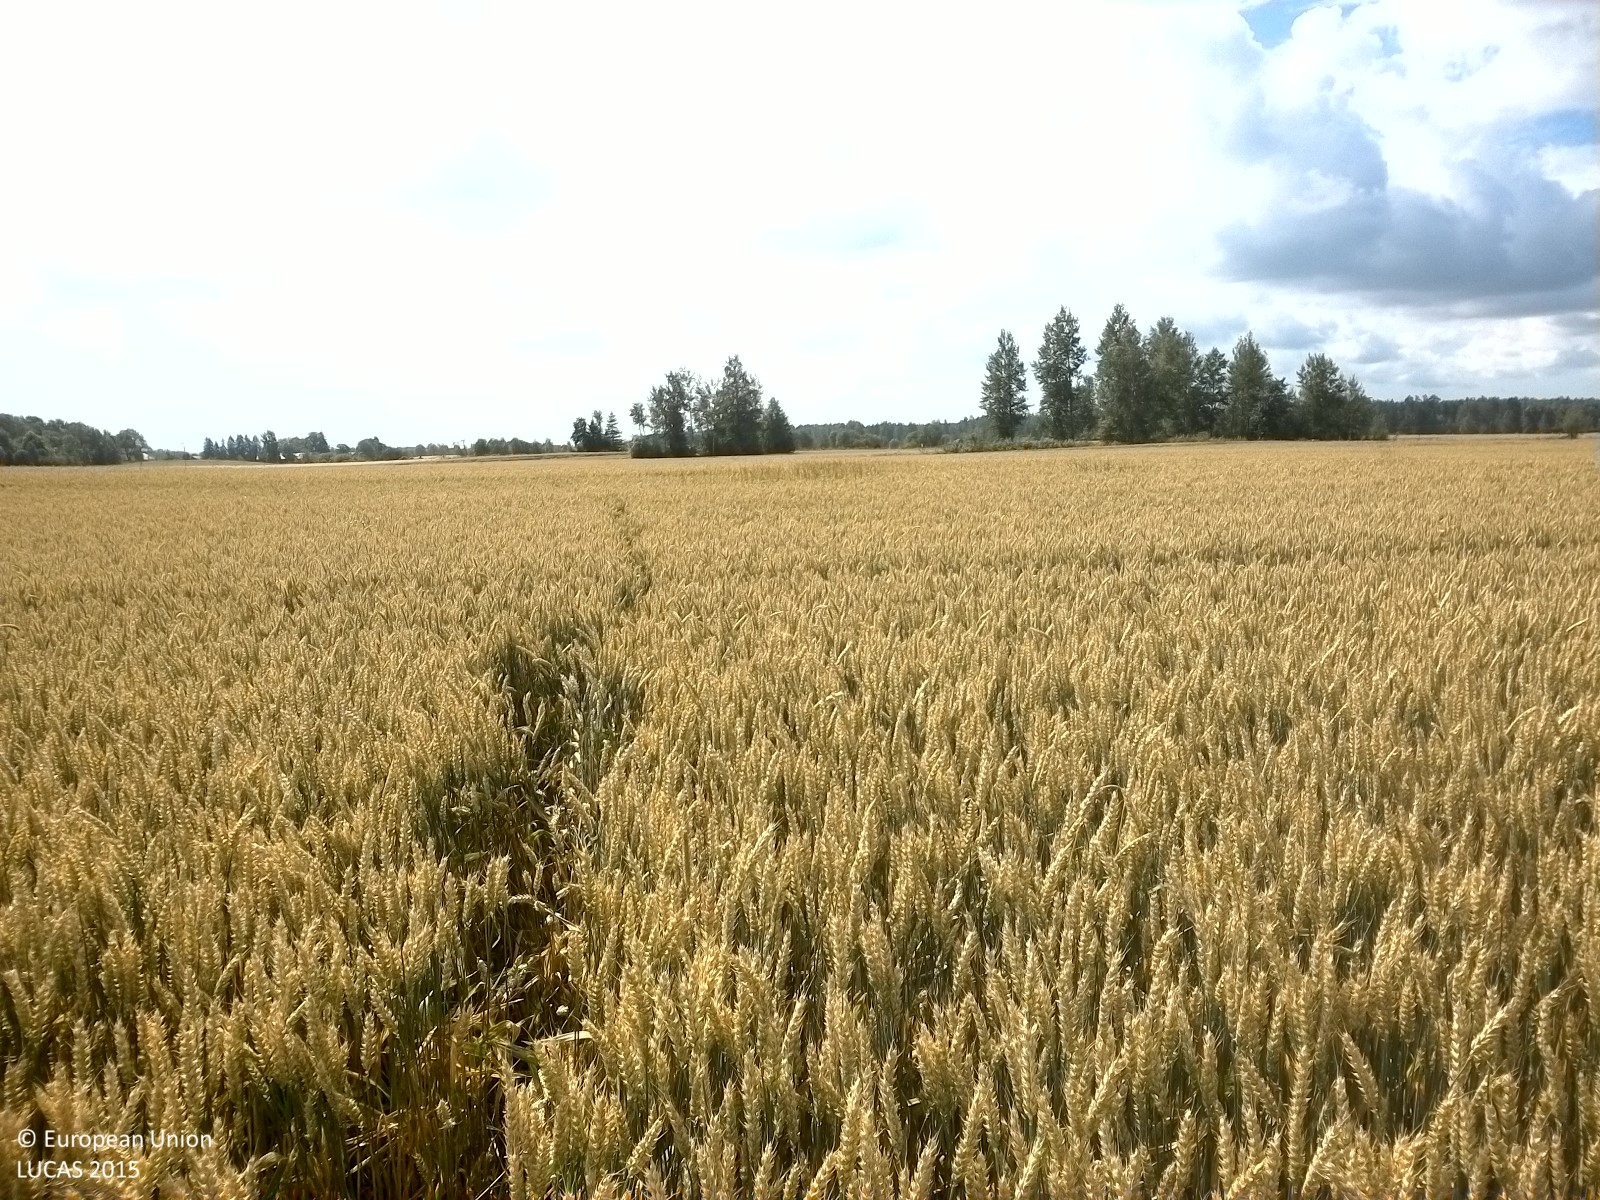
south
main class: Cropland
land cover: Common wheat
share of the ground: > 75 %
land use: Agriculture (excluding fallow land and kitchen gardens)
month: August
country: SE
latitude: 59.1692
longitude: 15.0824
